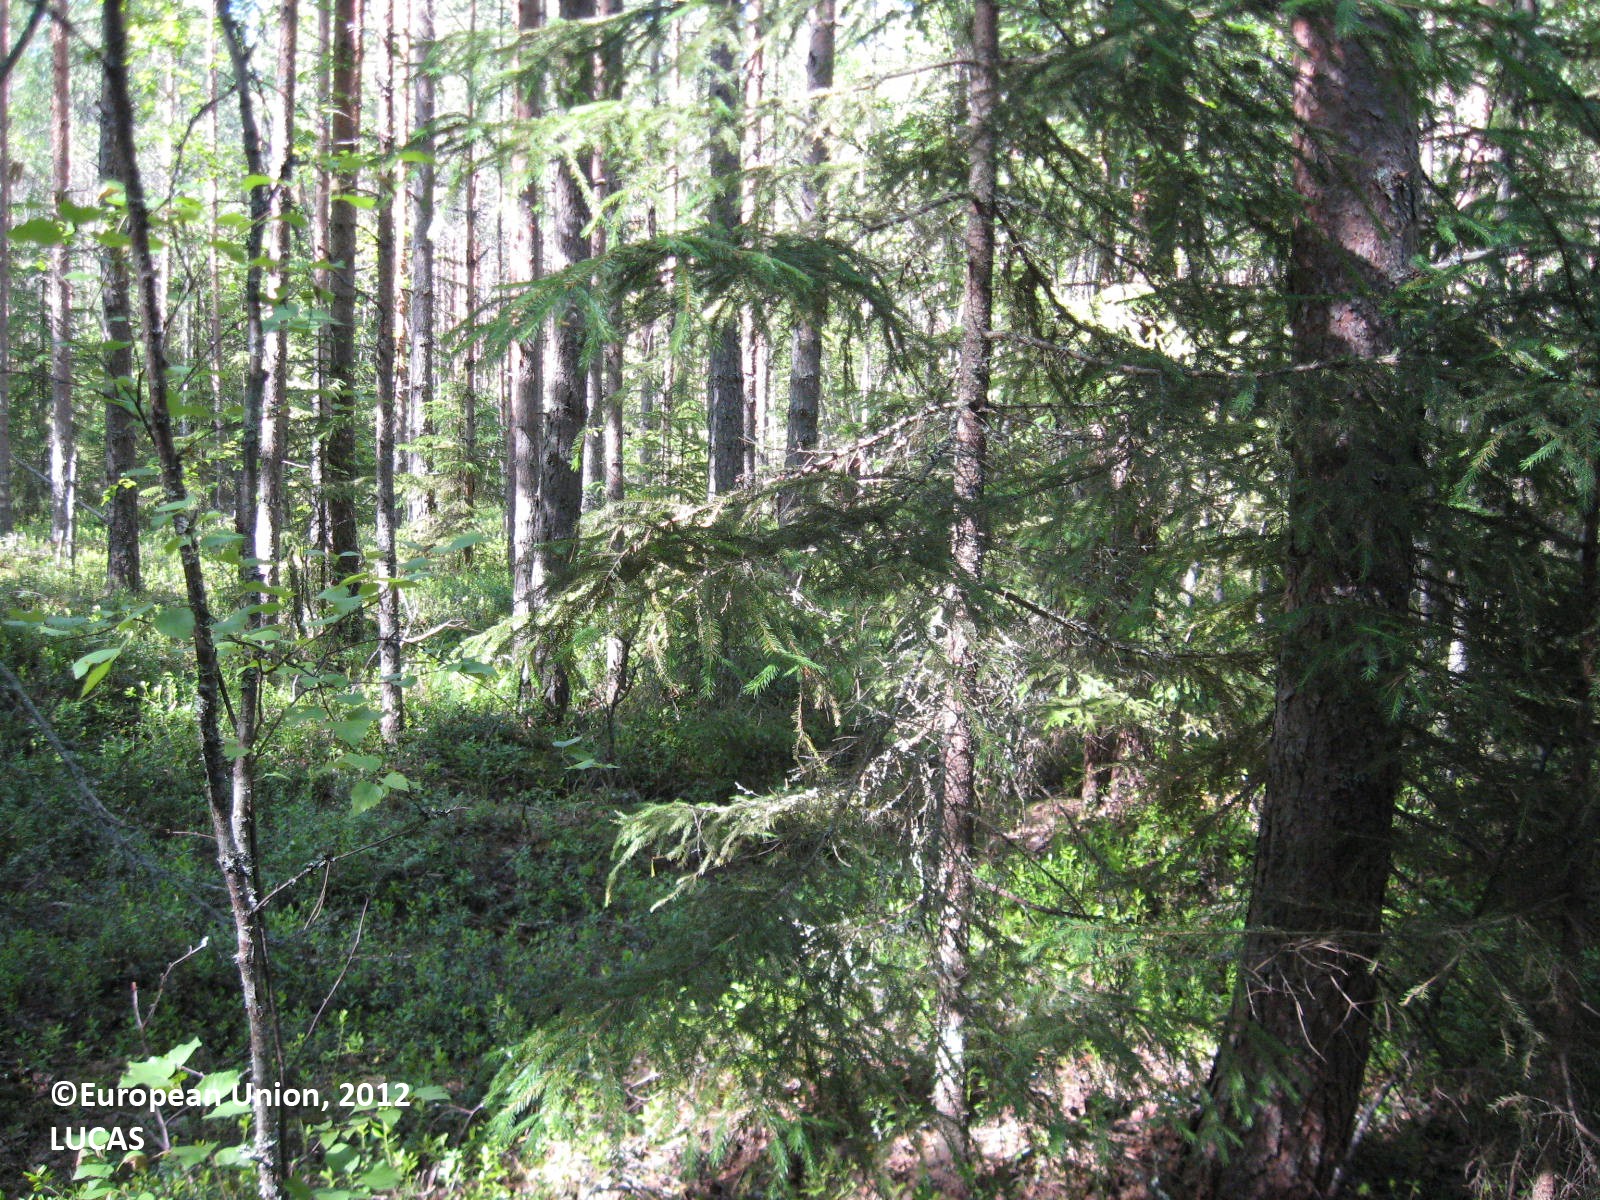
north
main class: Woodland
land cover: Other mixed woodland
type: boreal forest
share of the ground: > 75 %
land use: Forestry
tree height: > 5 m
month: June
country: FI
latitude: 62.6779
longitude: 21.7821
